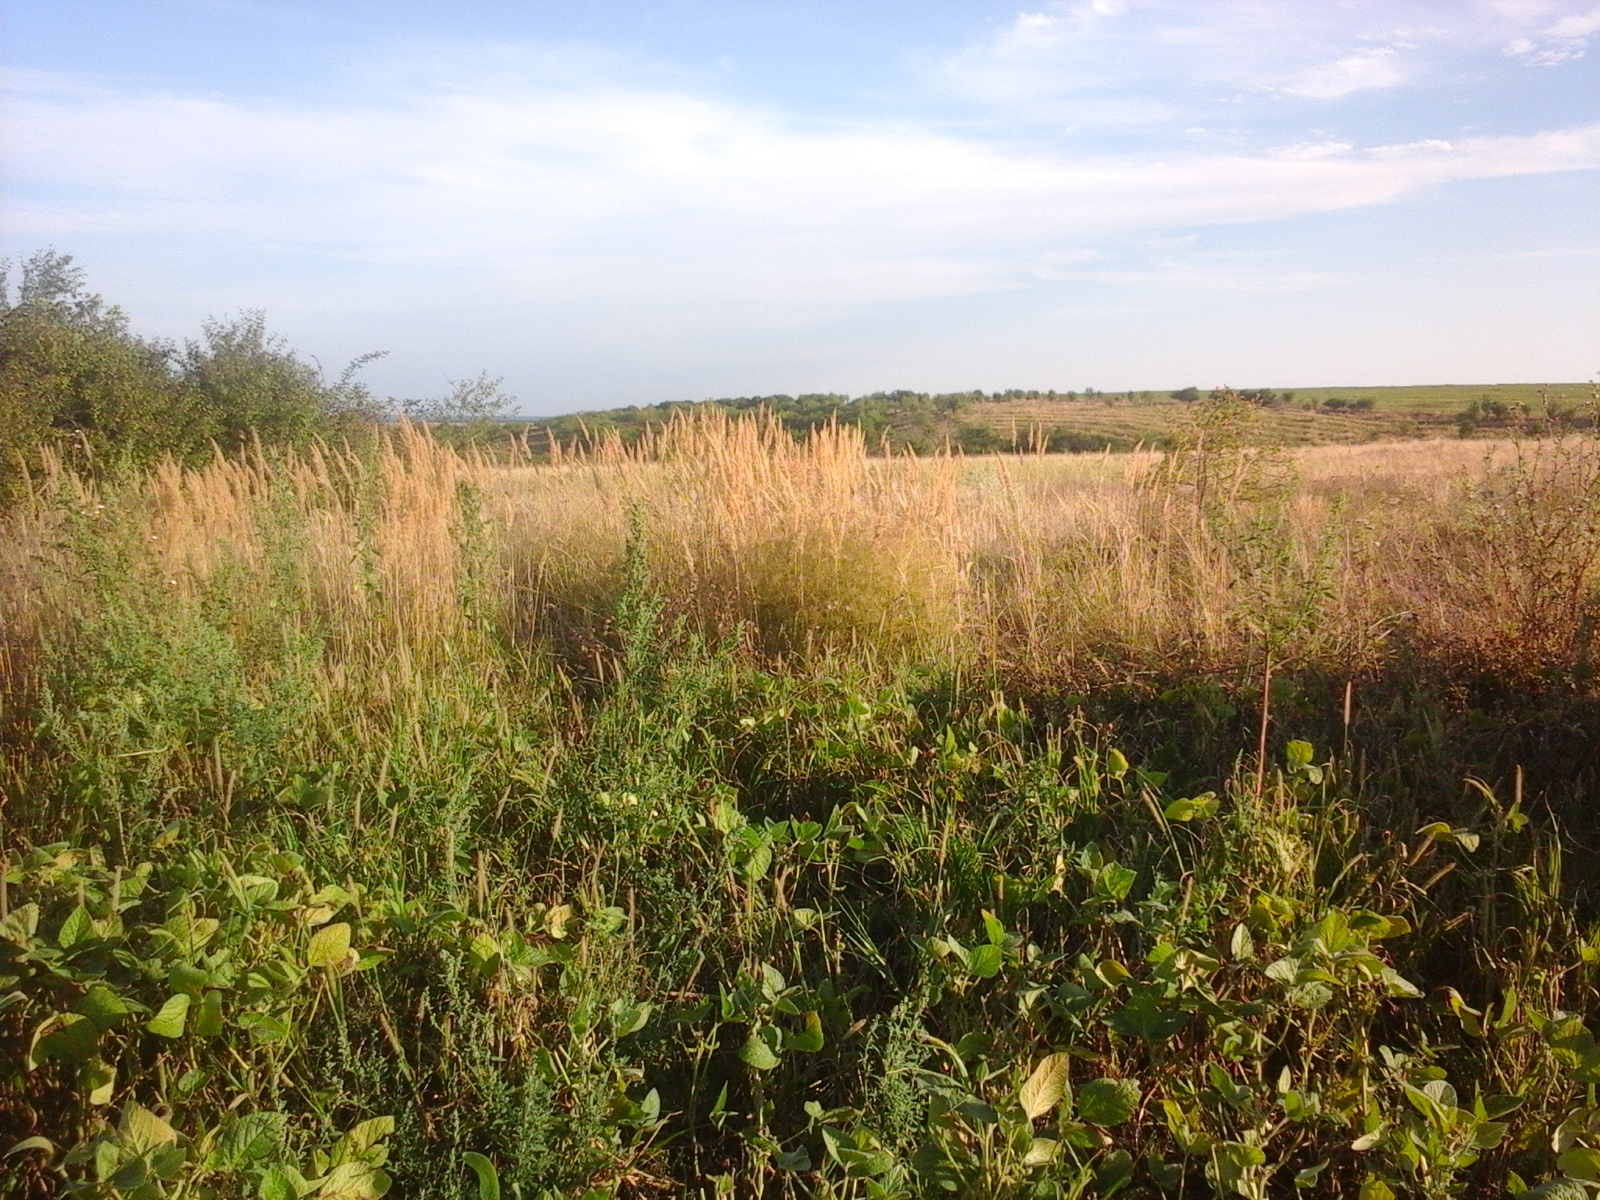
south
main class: Cropland
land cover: Soya
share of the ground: > 75 %
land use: Agriculture (excluding fallow land and kitchen gardens)
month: August
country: RO
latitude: 45.9809
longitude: 21.3536
